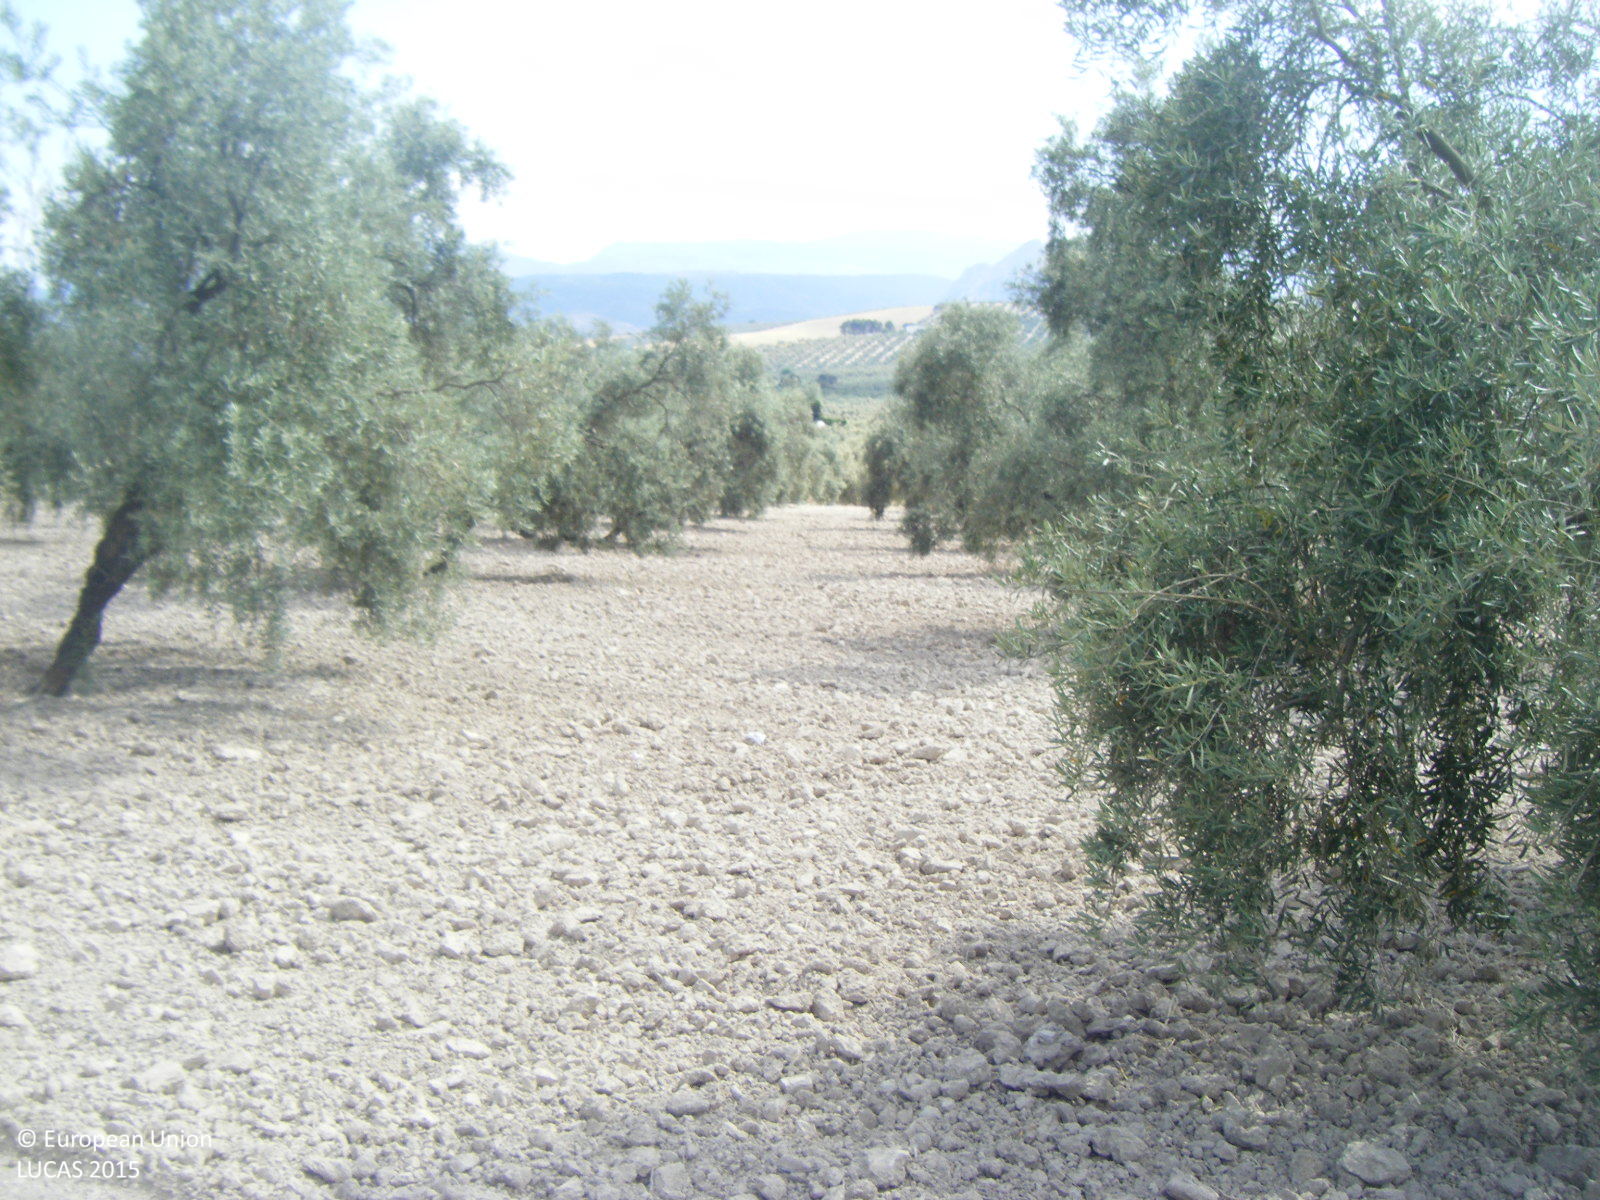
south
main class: Cropland
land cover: Olive groves
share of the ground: 10 - 25 %
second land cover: Other bare soil
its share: > 75 %
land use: Agriculture (excluding fallow land and kitchen gardens)
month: May
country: ES
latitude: 37.1356
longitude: -4.4401
